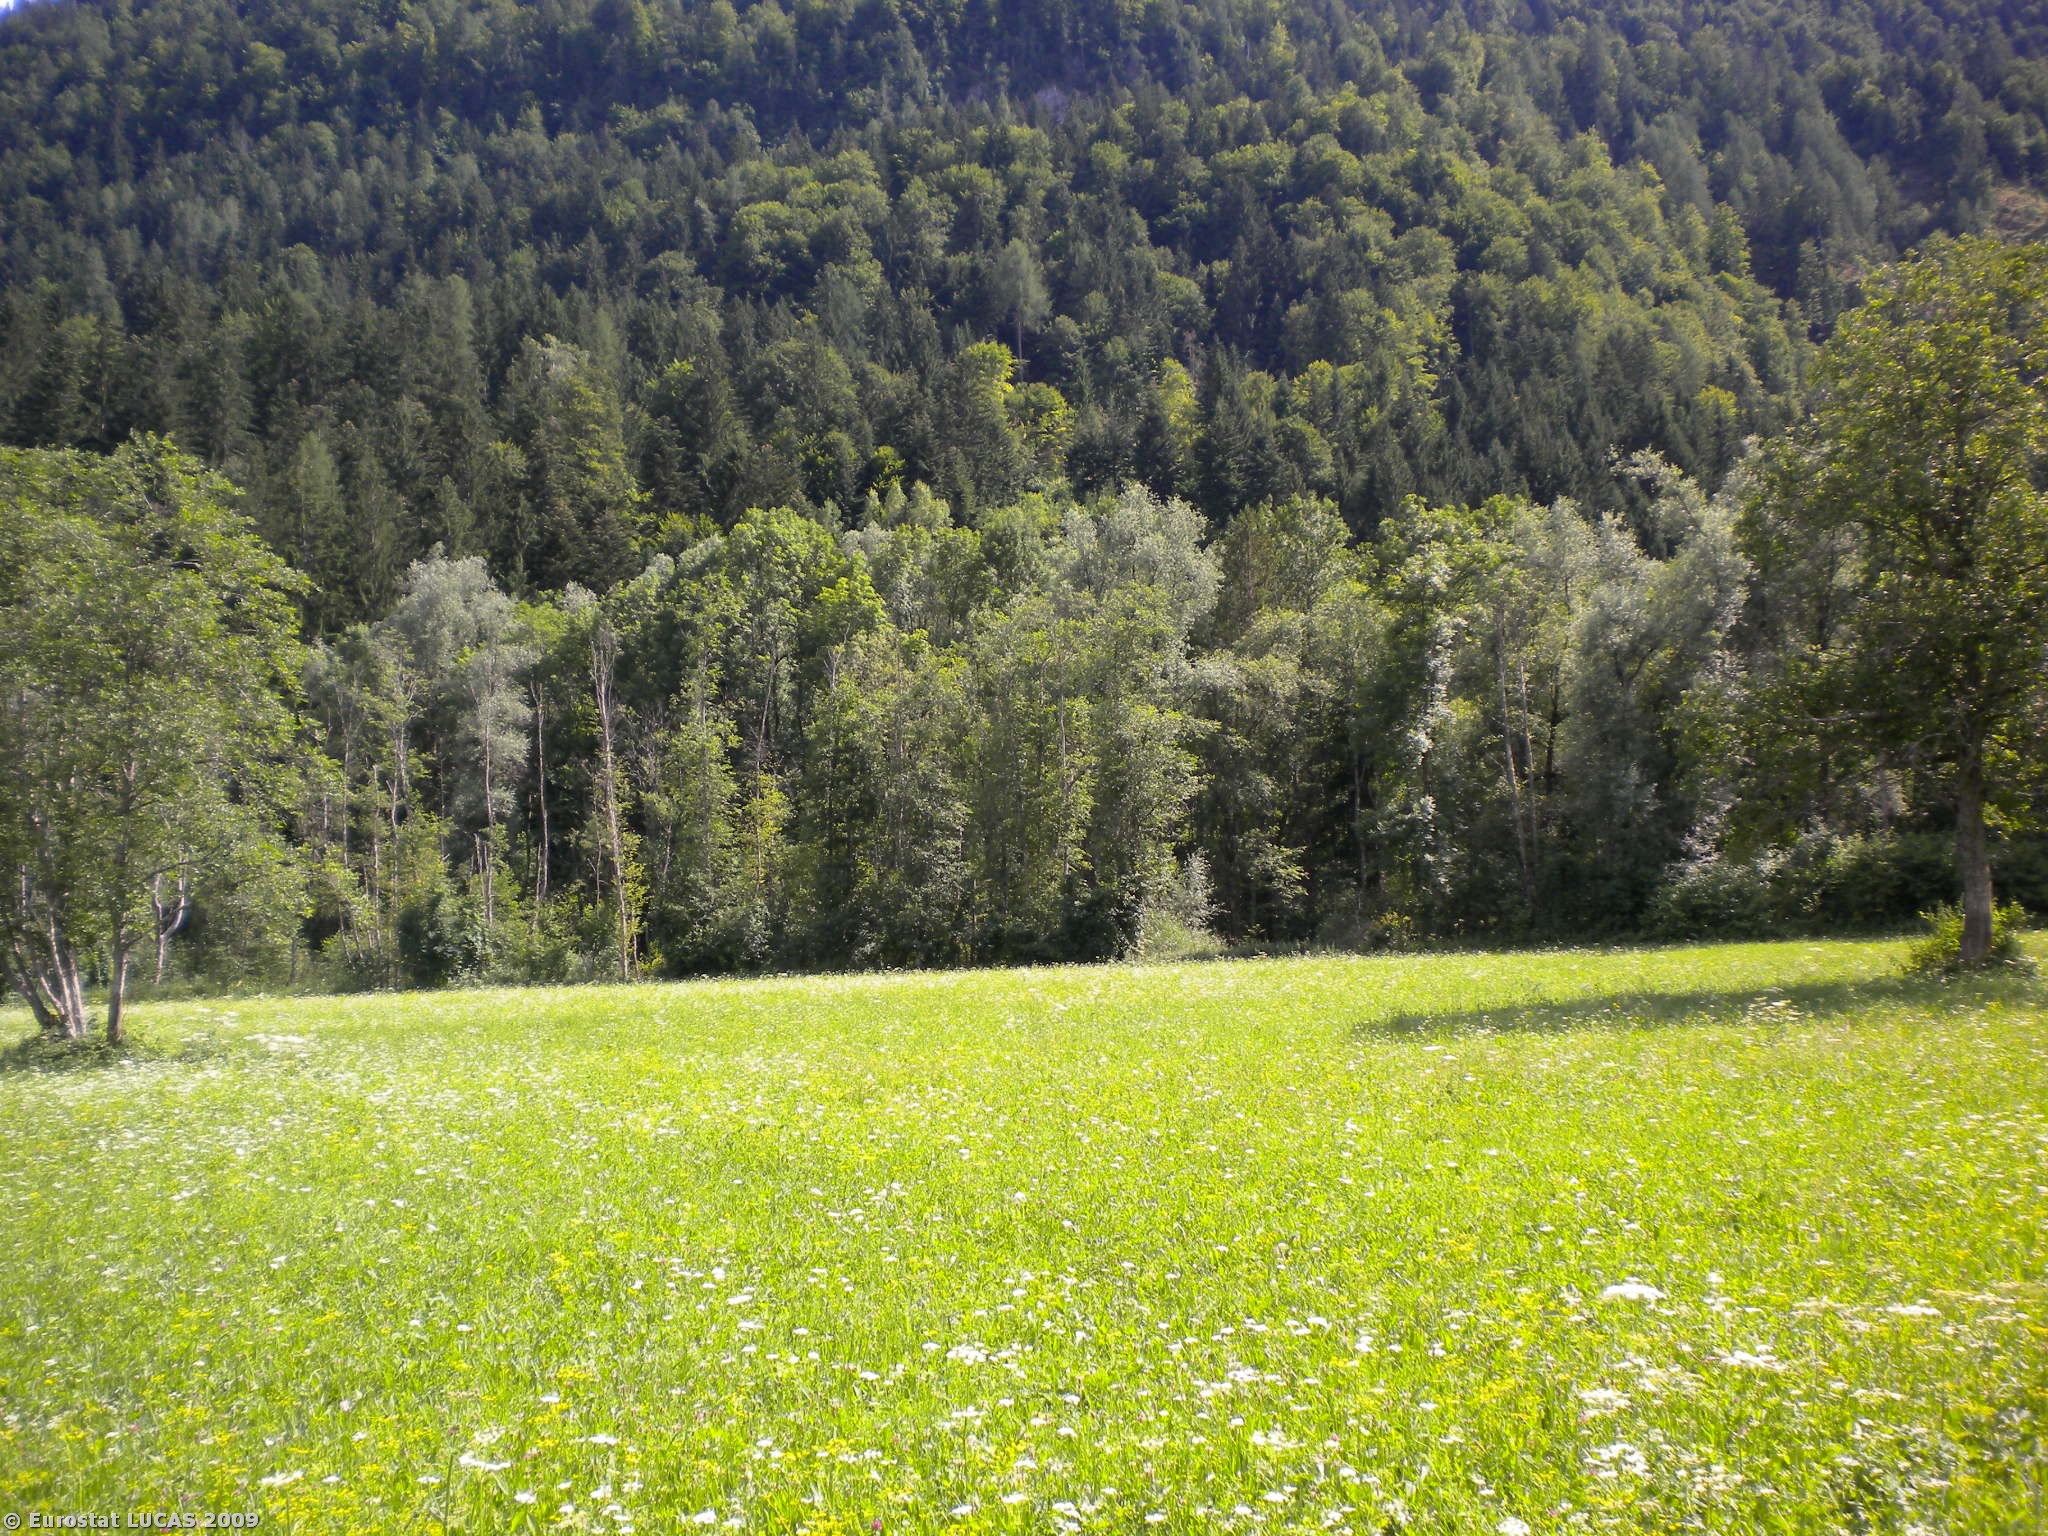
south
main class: Grassland
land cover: Grassland without tree/shrub cover
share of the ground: > 75 %
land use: Agriculture (excluding fallow land and kitchen gardens)
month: July
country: AT
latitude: 46.6018
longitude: 13.4566
